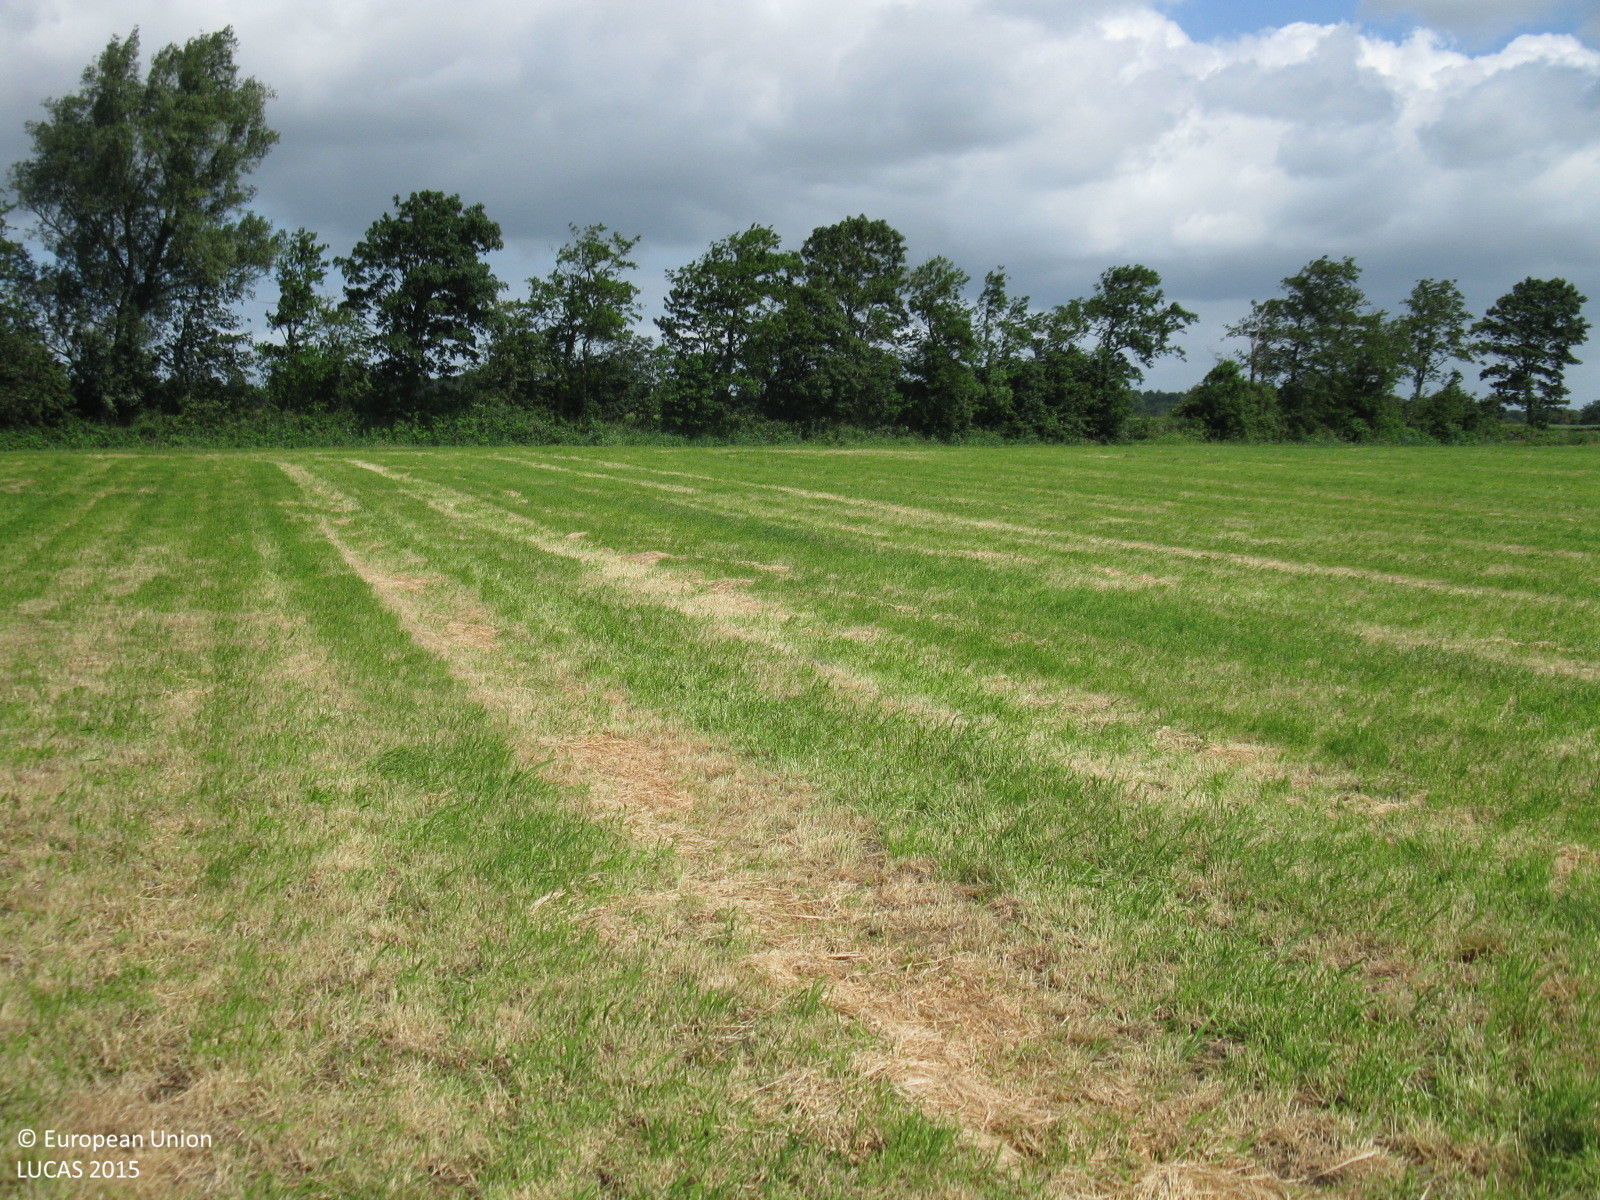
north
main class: Grassland
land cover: Grassland without tree/shrub cover
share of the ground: > 75 %
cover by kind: herbaceous plants 100 %
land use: Agriculture (excluding fallow land and kitchen gardens)
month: July
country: DE
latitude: 53.4732
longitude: 7.8764
